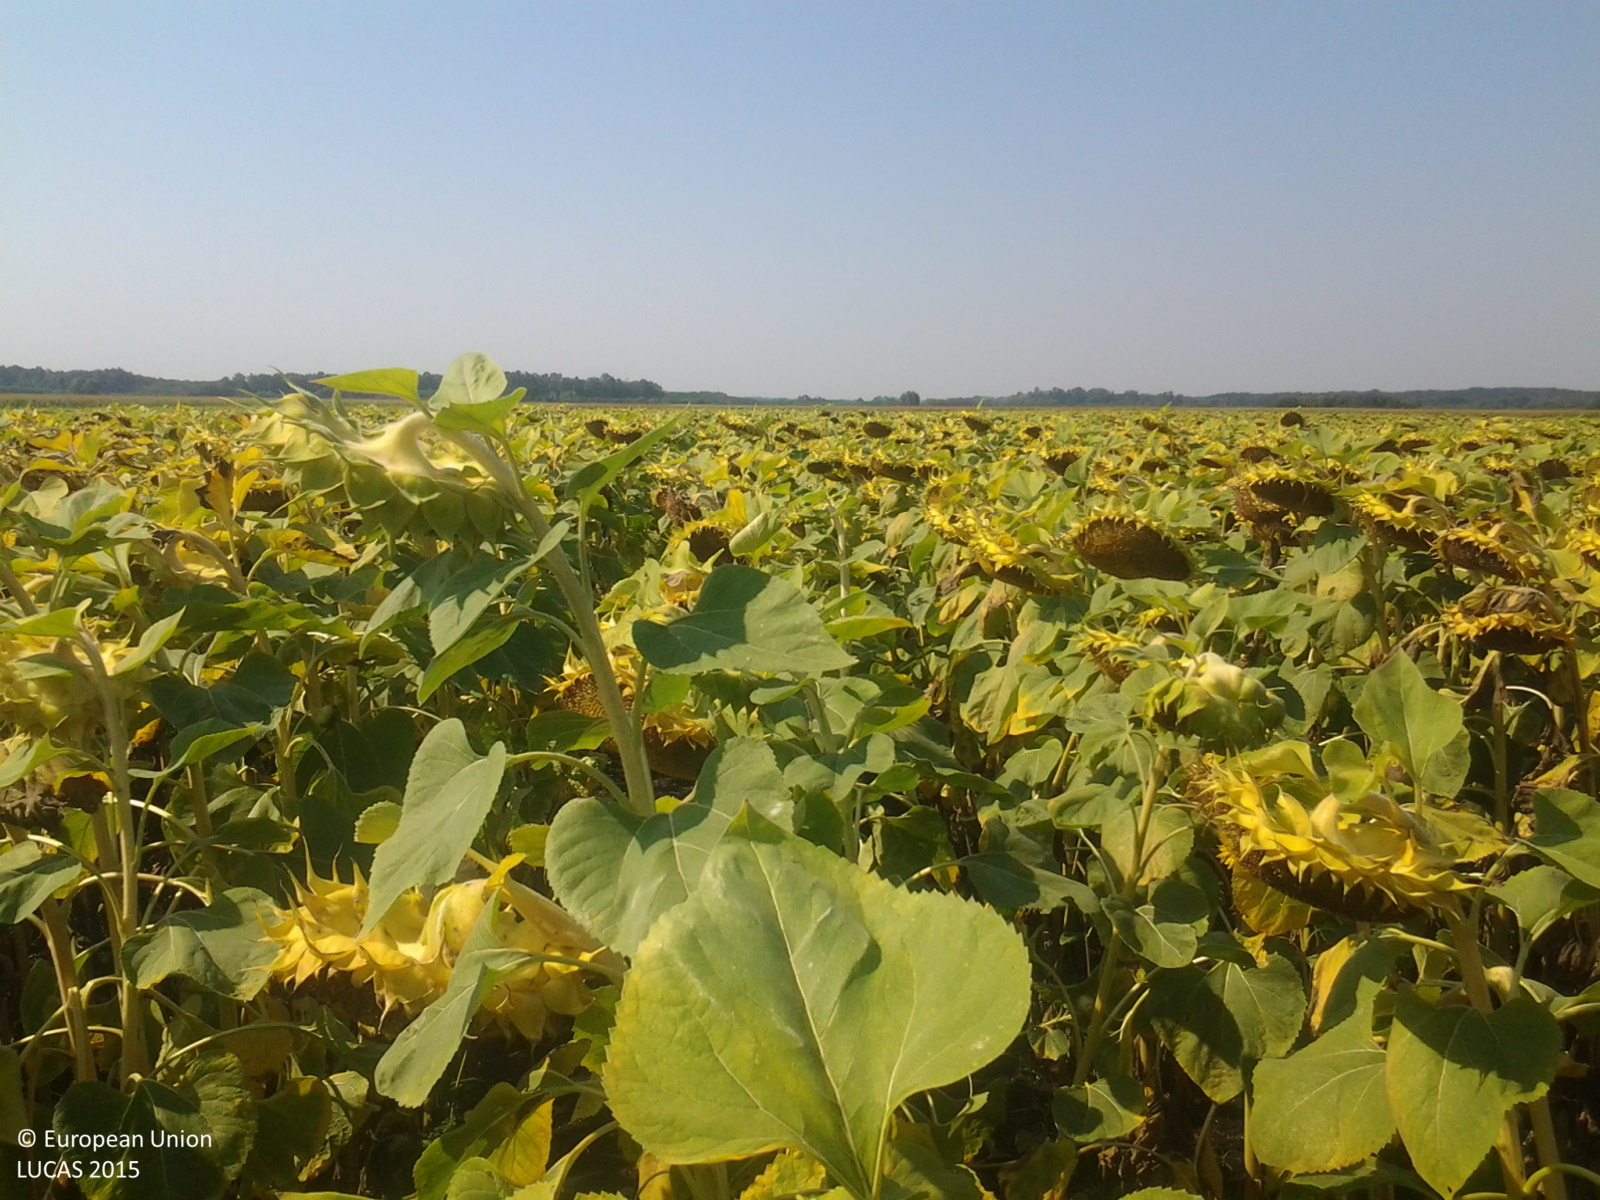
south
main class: Cropland
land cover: Sunflower
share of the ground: > 75 %
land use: Agriculture (excluding fallow land and kitchen gardens)
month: August
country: HU
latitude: 46.9051
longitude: 21.2082
